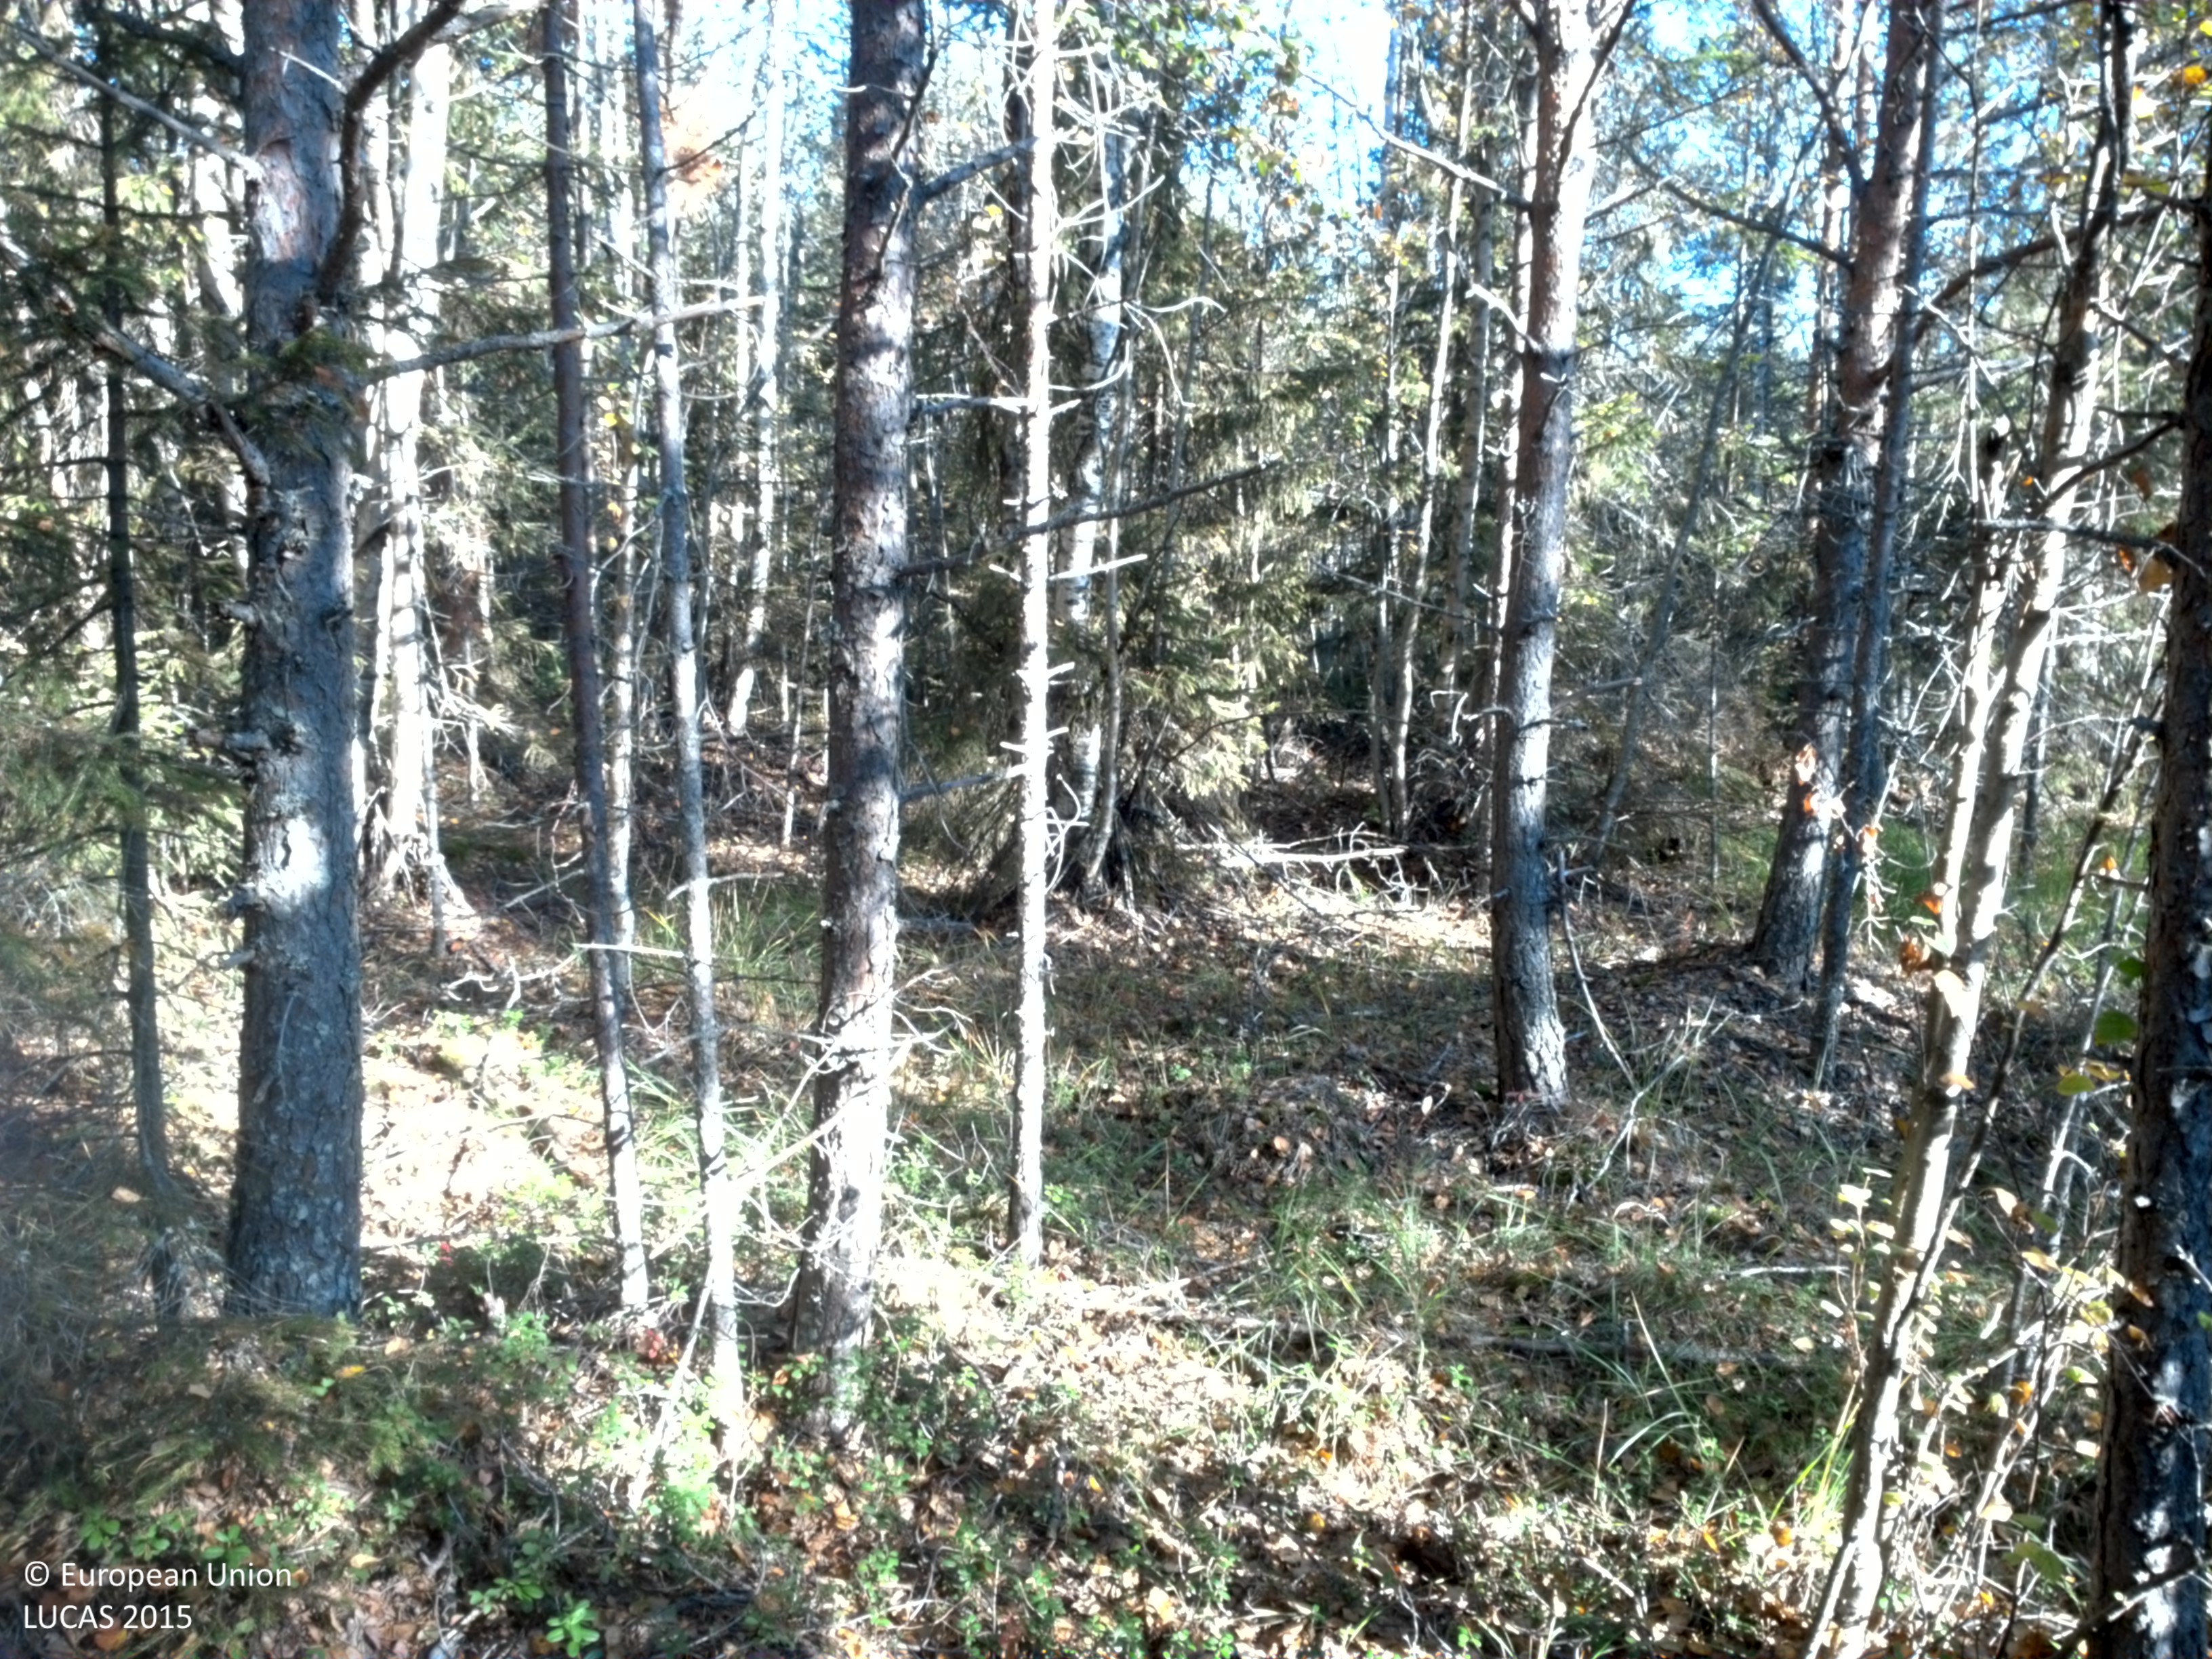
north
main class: Woodland
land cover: Pine dominated mixed woodland
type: boreal forest
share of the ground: 50 - 75 %
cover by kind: coniferous forest trees 35 %, broadleaved forest trees 30 %, shrubs 20 %, unconsolidated bare surface 10 %, lichens and mosses 5 %
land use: Forestry
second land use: Amenities, museums, leisure
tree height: < 5 m
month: September
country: SE
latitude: 65.5640
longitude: 22.3523
